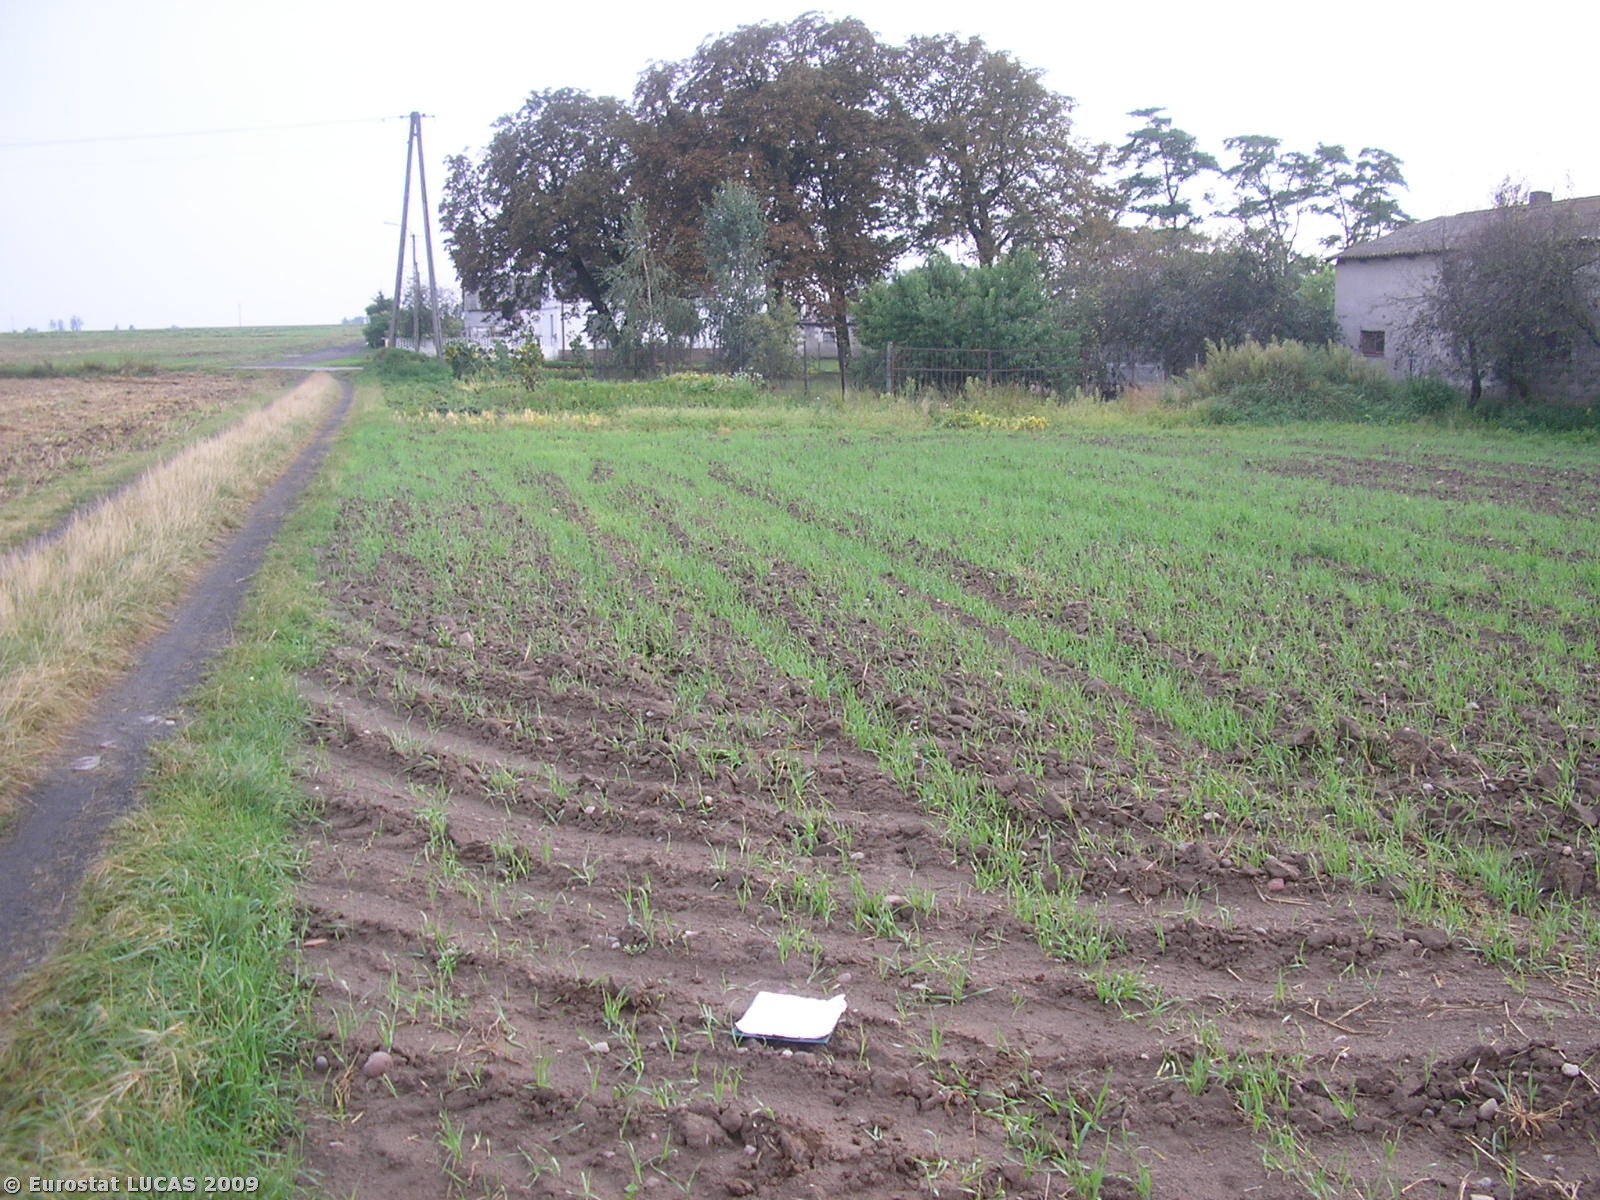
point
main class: Cropland
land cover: Common wheat
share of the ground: < 10 %
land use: Agriculture (excluding fallow land and kitchen gardens)
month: August
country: PL
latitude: 52.3177
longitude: 19.5490
